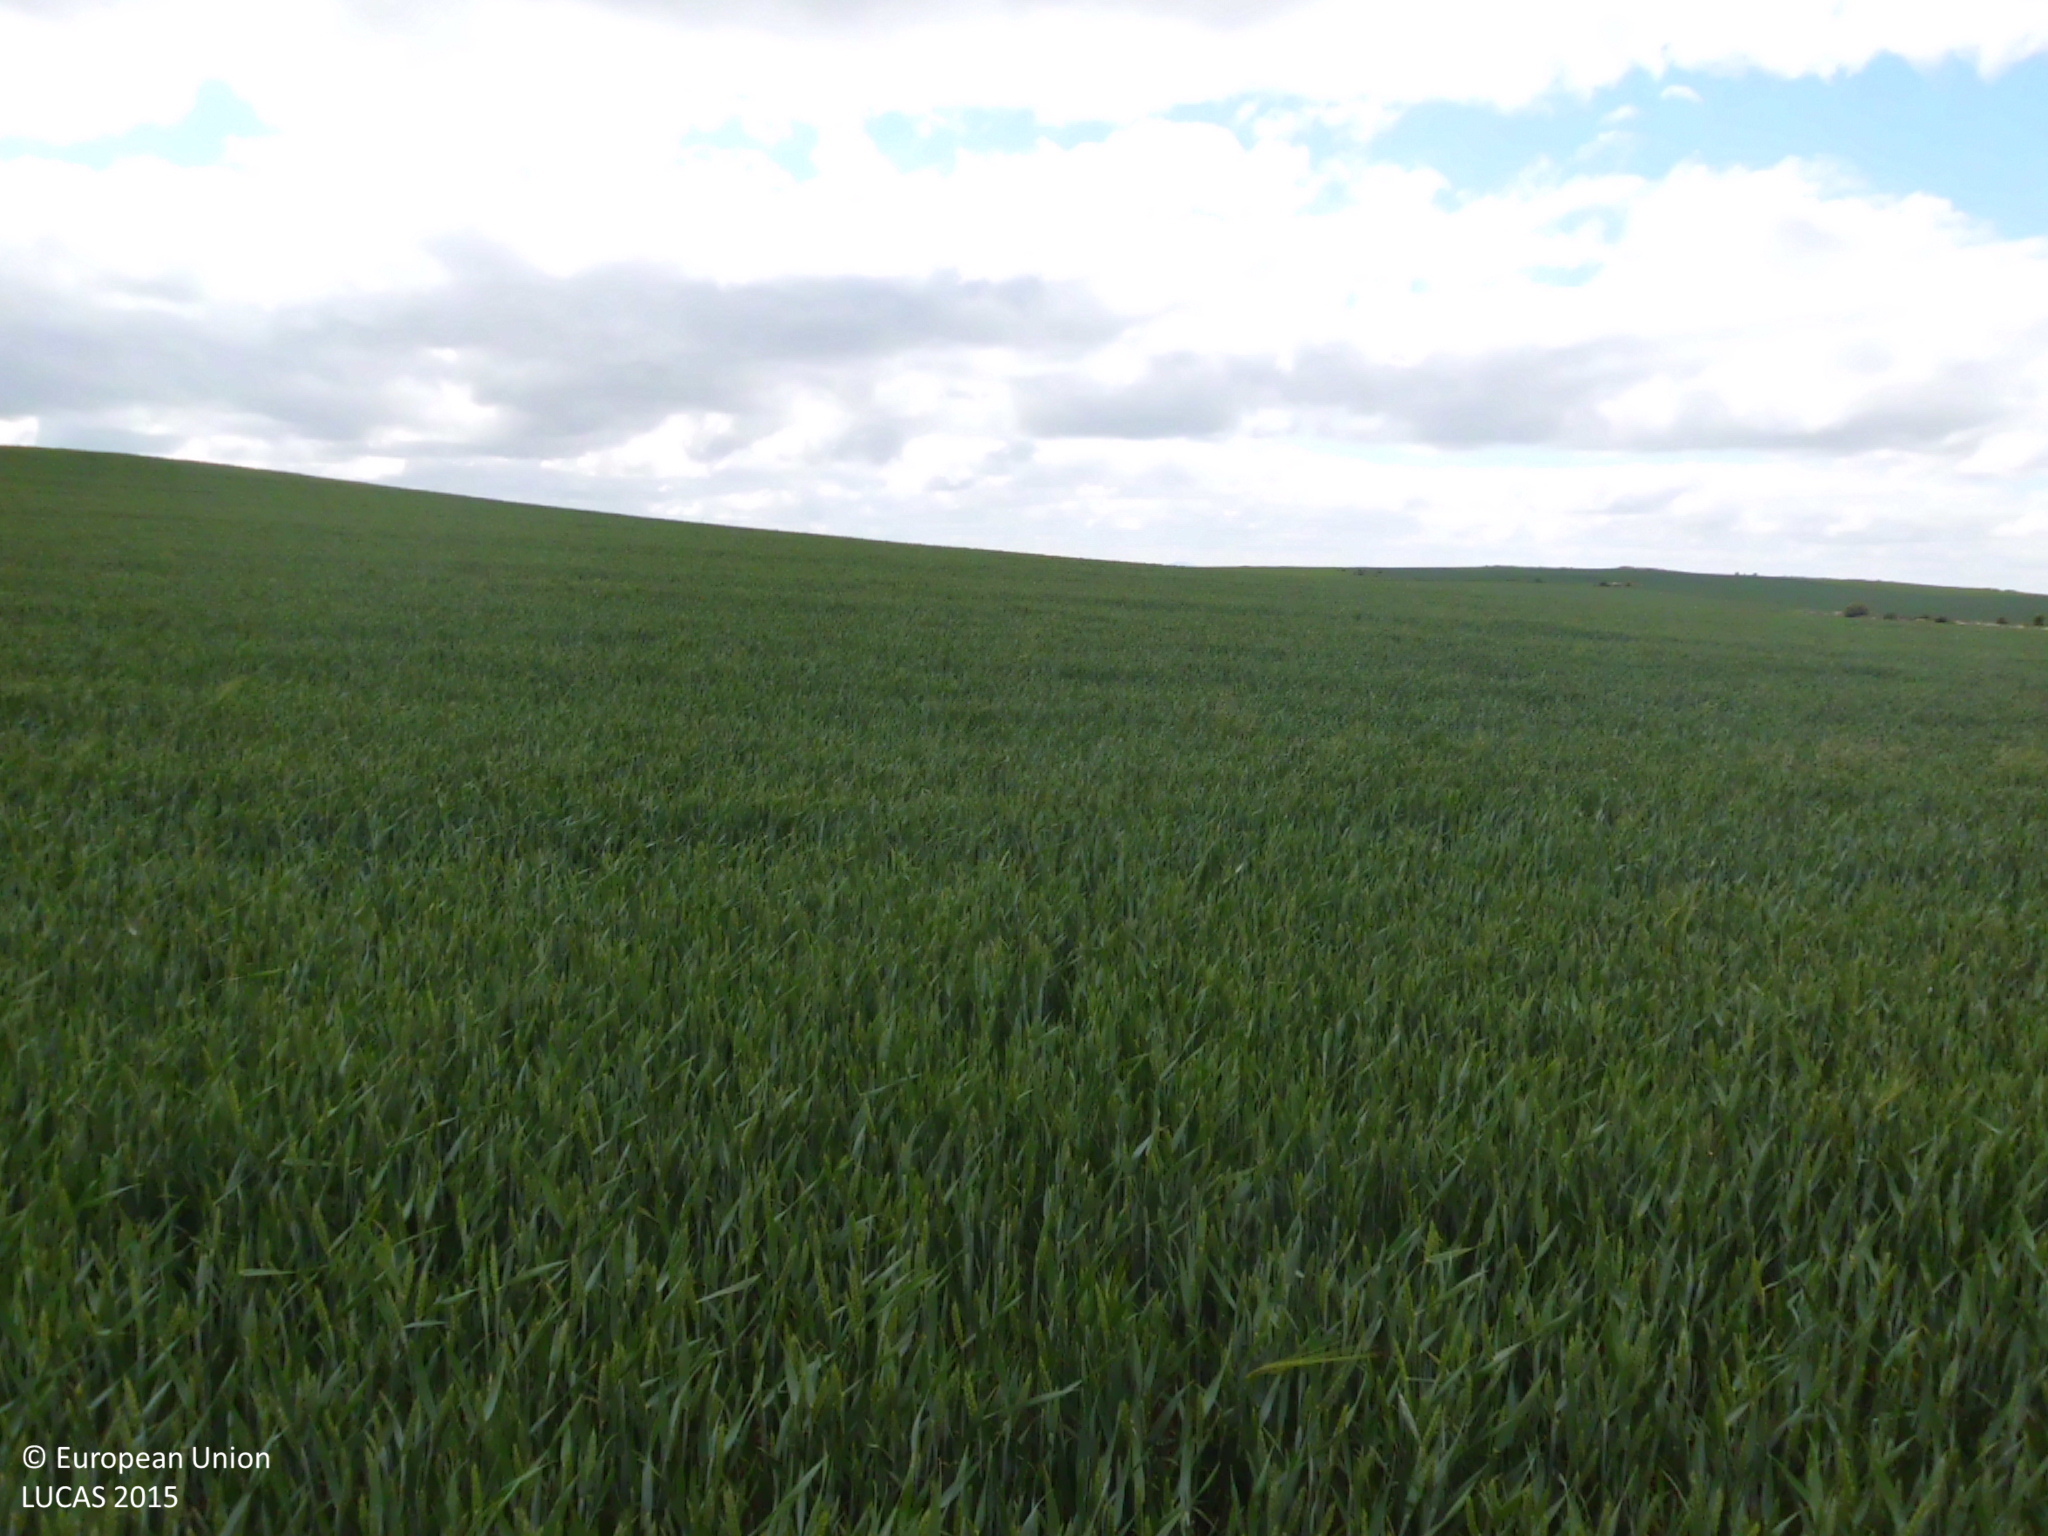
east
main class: Cropland
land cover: Common wheat
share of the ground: > 75 %
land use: Agriculture (excluding fallow land and kitchen gardens)
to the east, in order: Common wheat; Lucerne; Grass margins; Barley
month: May
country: ES
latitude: 42.3891
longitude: -3.8750
